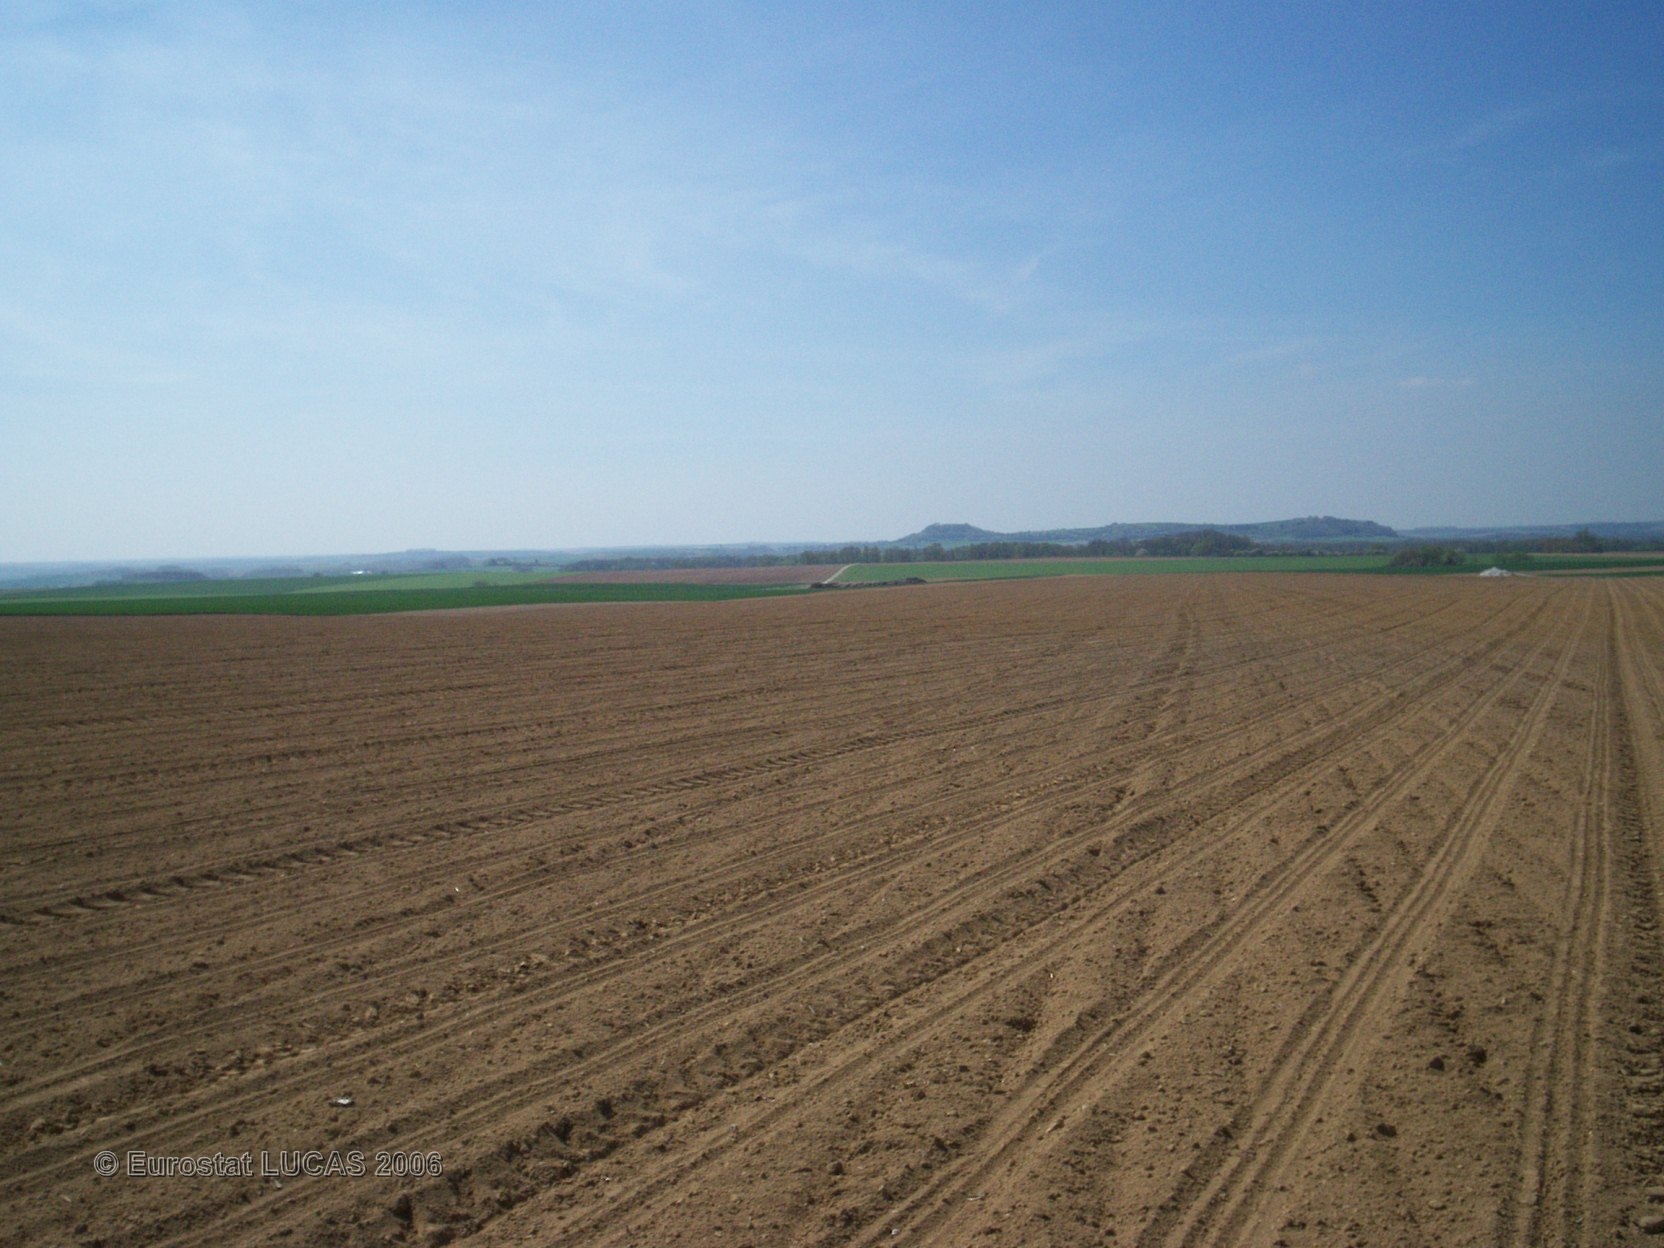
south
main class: Cropland
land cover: Maize
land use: Agriculture (excluding fallow land and kitchen gardens)
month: April
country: FR
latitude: 49.6315
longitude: 4.3885
